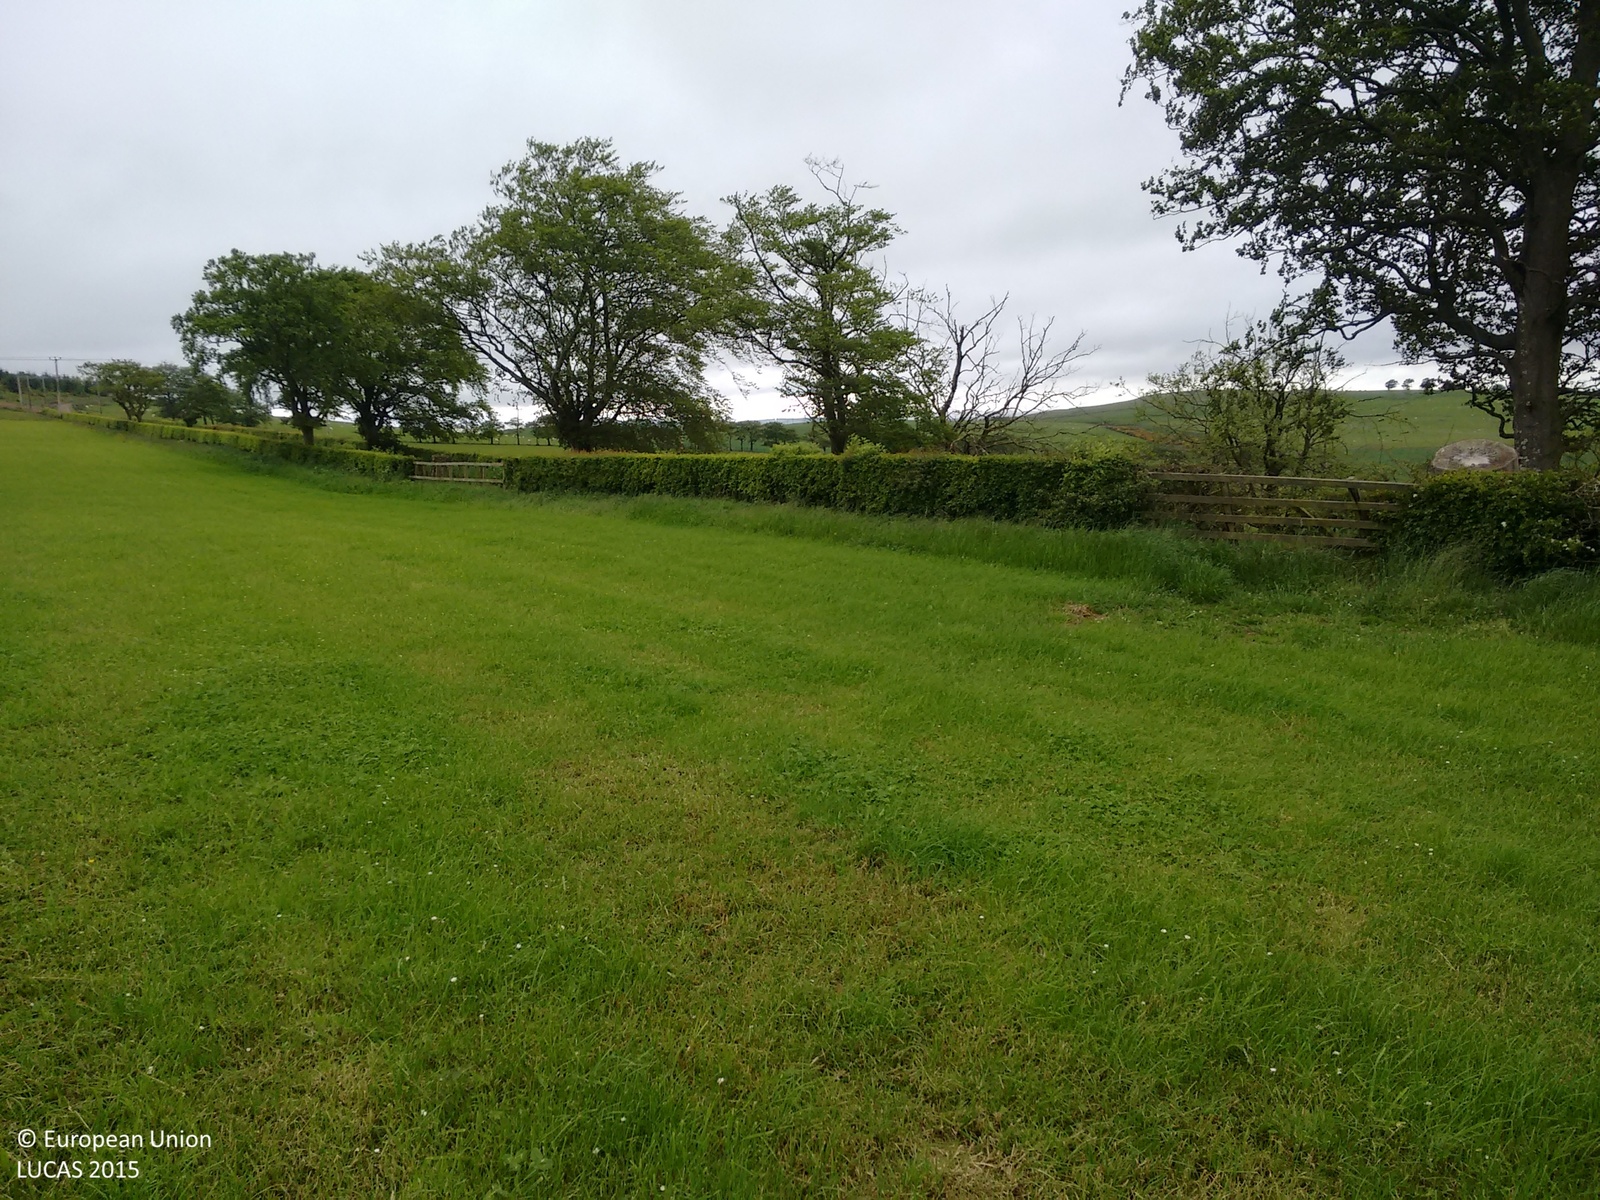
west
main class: Grassland
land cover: Grassland without tree/shrub cover
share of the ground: > 75 %
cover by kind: herbaceous plants 100 %
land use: Agriculture (excluding fallow land and kitchen gardens)
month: June
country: GB
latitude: 55.6529
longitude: -3.8321
